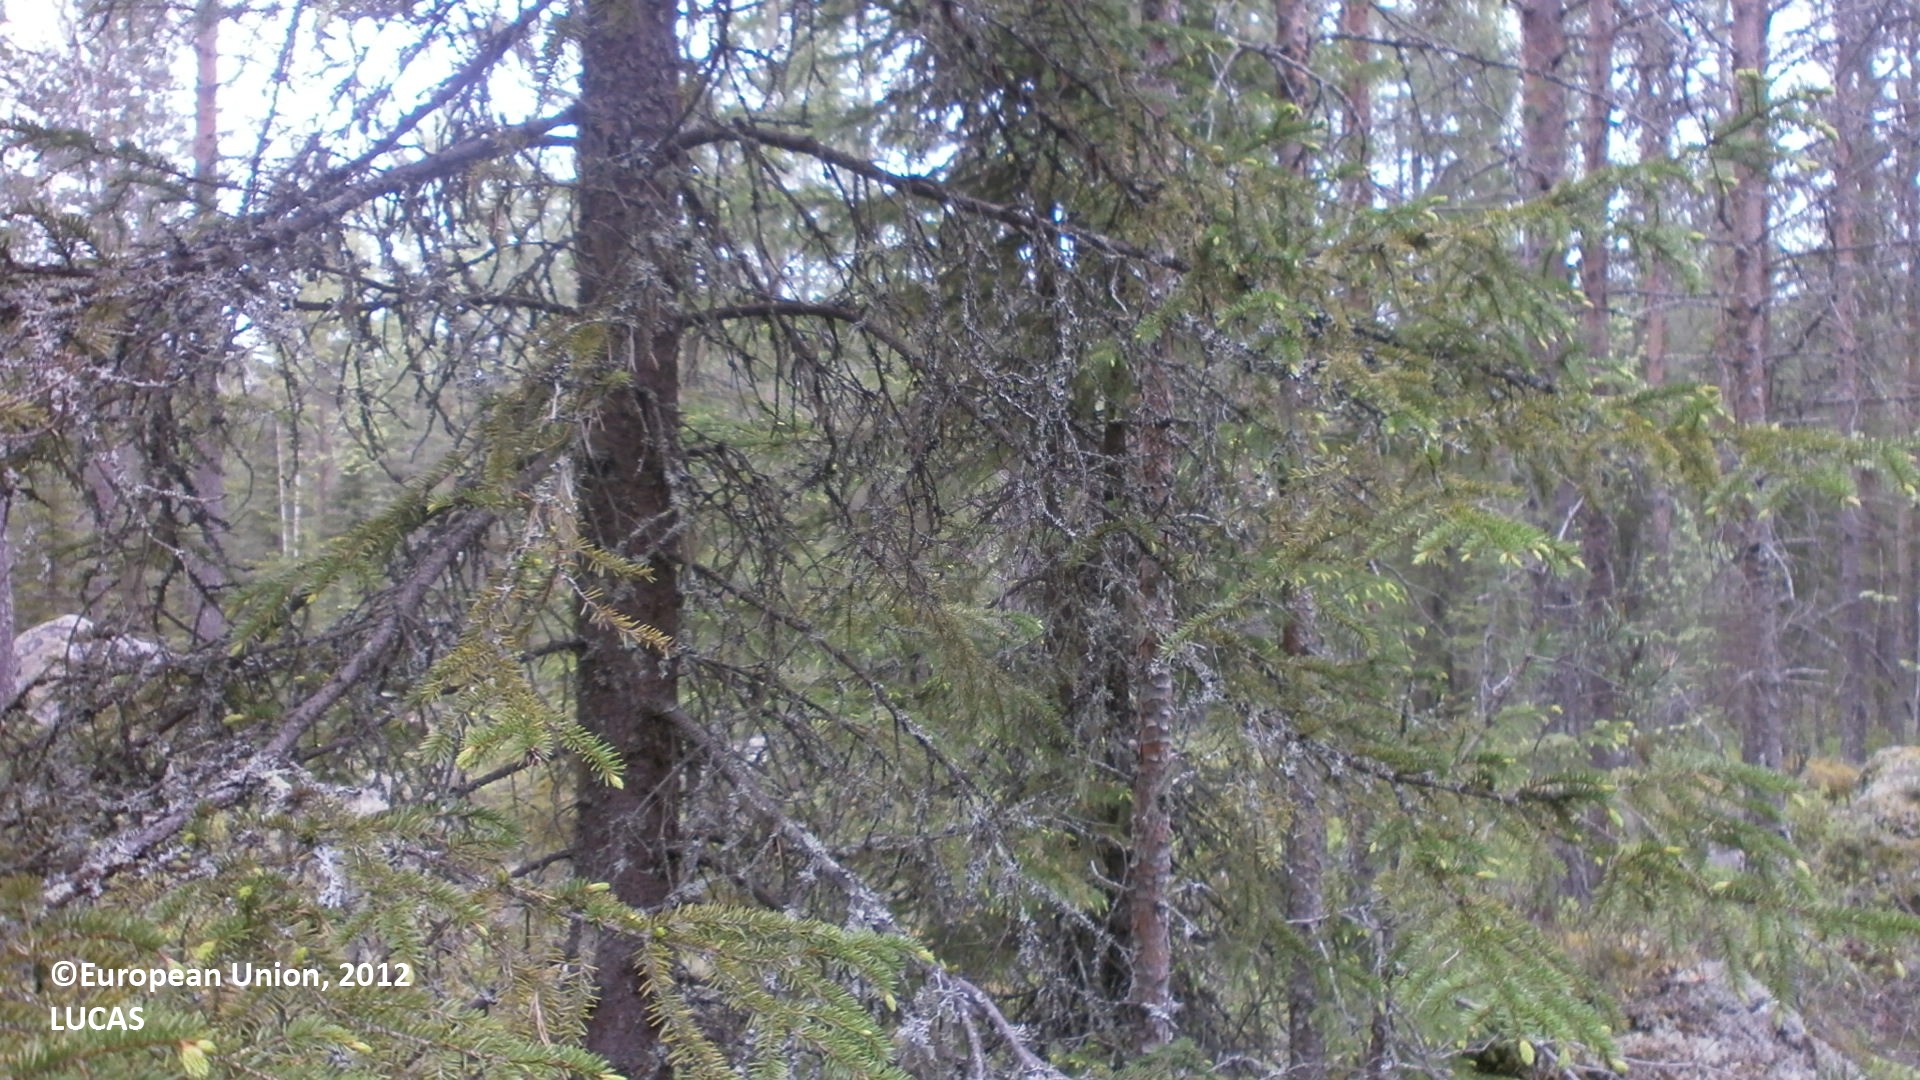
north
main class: Woodland
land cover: Pine dominated coniferous woodland
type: hemiboreal forest and nemoral coniferous forest and mixed broadleaved-coniferous forest
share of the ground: 25 - 50 %
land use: Forestry
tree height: > 5 m
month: June
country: FI
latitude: 64.4410
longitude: 25.1437
